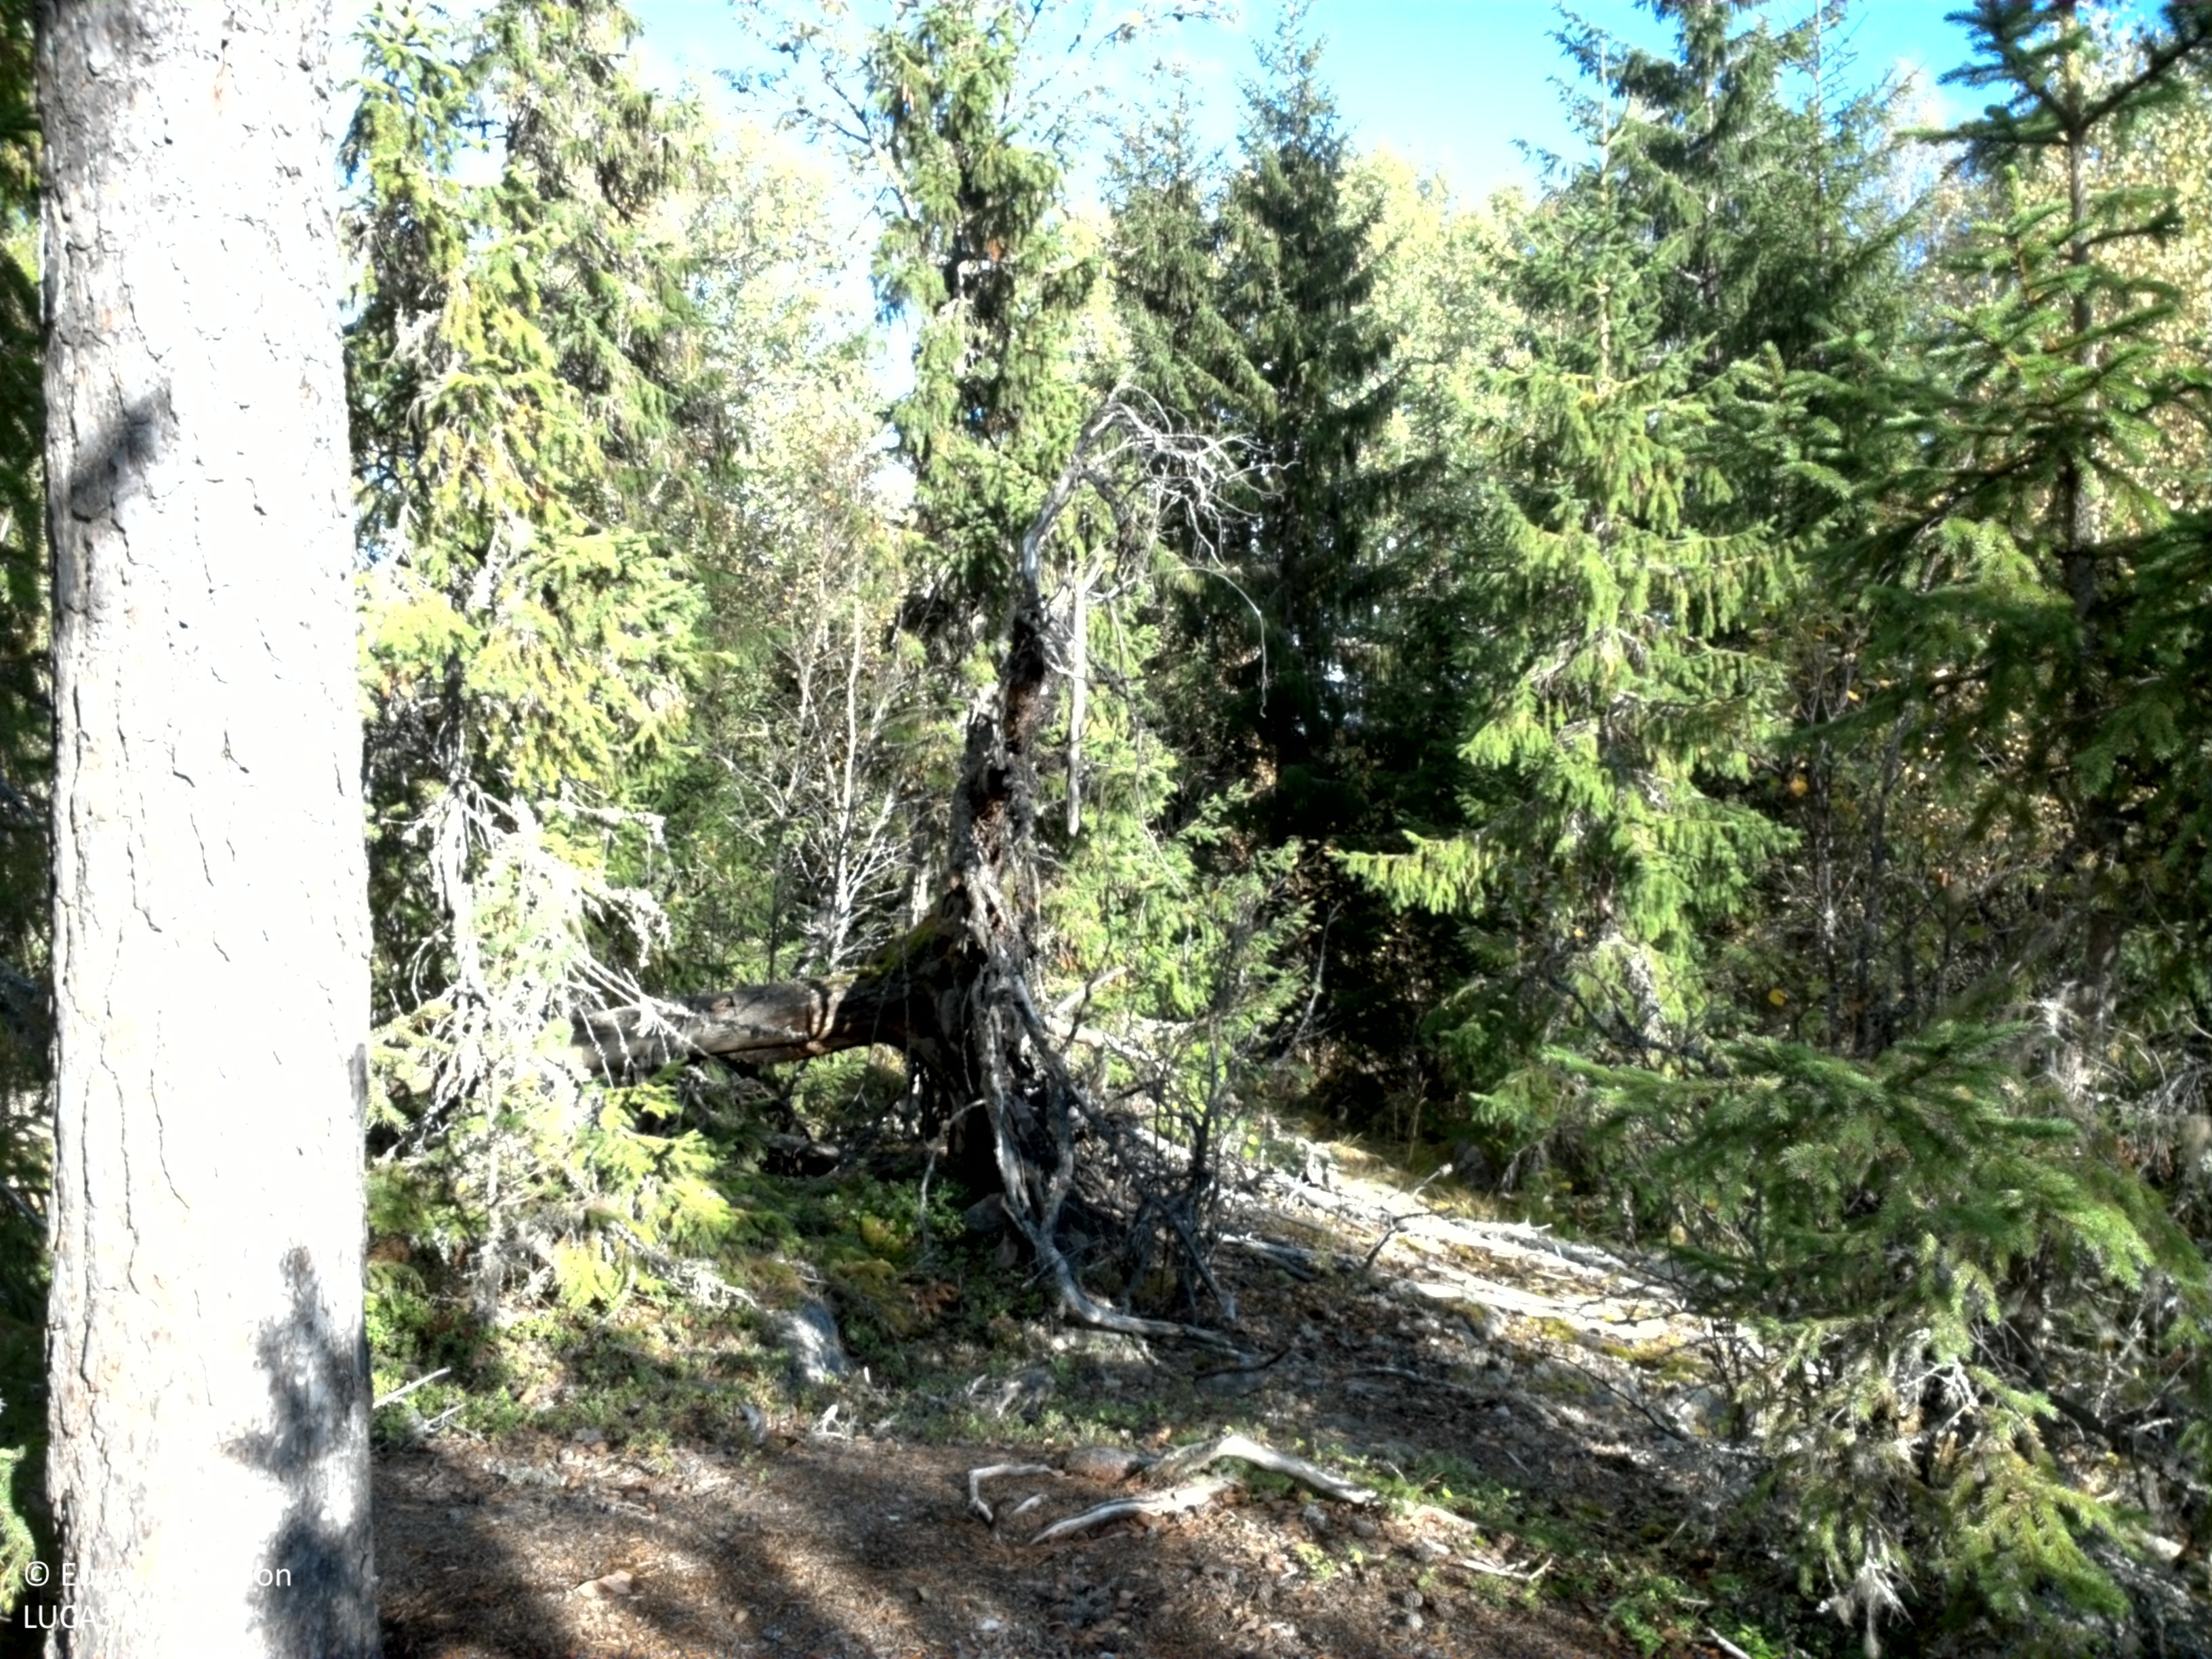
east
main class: Woodland
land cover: Spruce dominated mixed woodland
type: boreal forest
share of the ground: 50 - 75 %
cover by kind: coniferous forest trees 35 %, shrubs 20 %, herbaceous plants 20 %, broadleaved forest trees 15 %, unconsolidated bare surface 10 %
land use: Forestry
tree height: > 5 m
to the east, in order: Spruce dominated mixed woodland; Other coniferous woodland; Spruce dominated coniferous woodland; Spruce dominated mixed woodland; Broadleaved woodland; Ditches and canals; Temporary grasslands; Ditches and canals; Grass margins; Paved roads, cycling and walking lanes; Ditches and canals; Temporary grasslands
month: September
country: SE
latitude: 60.1185
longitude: 16.5582
